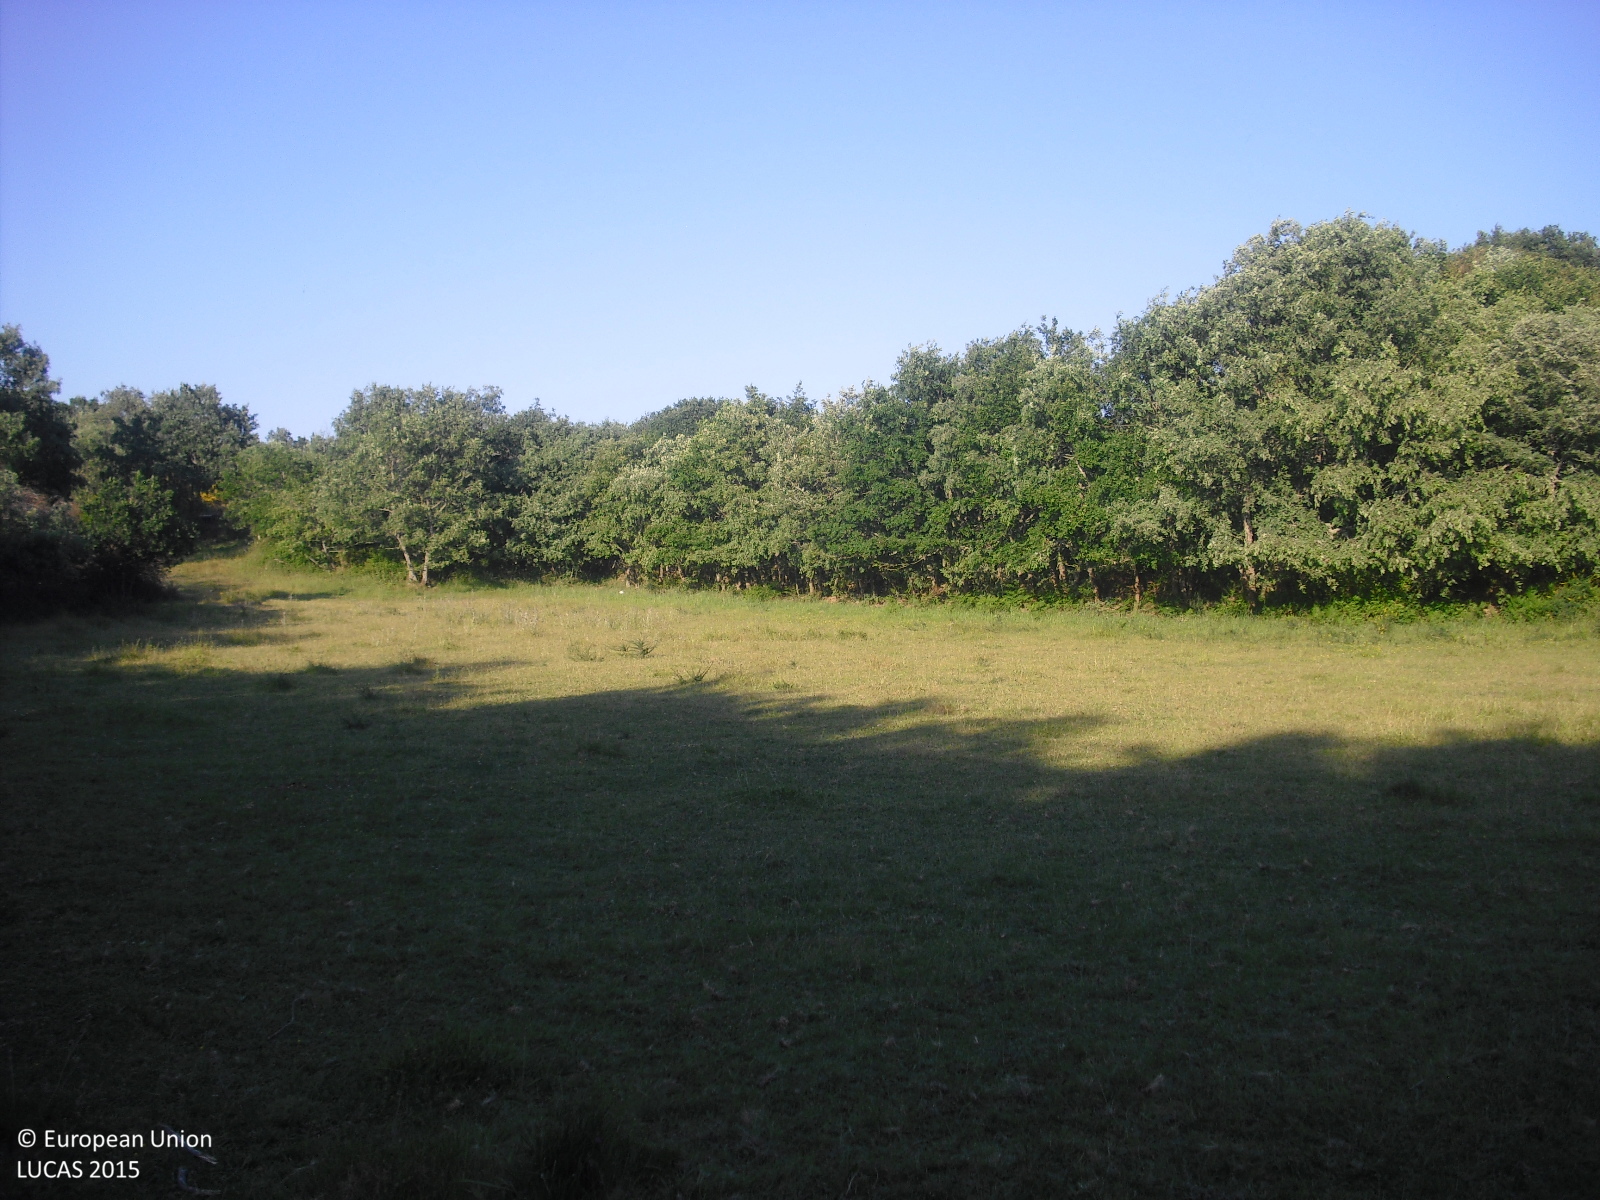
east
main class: Grassland
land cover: Grassland without tree/shrub cover
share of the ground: > 75 %
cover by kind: herbaceous plants 100 %
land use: Agriculture (excluding fallow land and kitchen gardens)
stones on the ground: < 10 %
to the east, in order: Grassland without tree/shrub cover; Broadleaved woodland; Shruby margins; Dry stone walls; Grass margins; Paved roads, cycling and walking lanes; Grass margins; Ditches and canals; Dry stone walls; Shruby margins; Grassland without tree/shrub cover; Shruby margins; Grassland without tree/shrub cover; Dry stone walls; Broadleaved woodland; Dry stone walls; Shruby margins
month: May
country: ES
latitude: 42.2375
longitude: -7.7278
